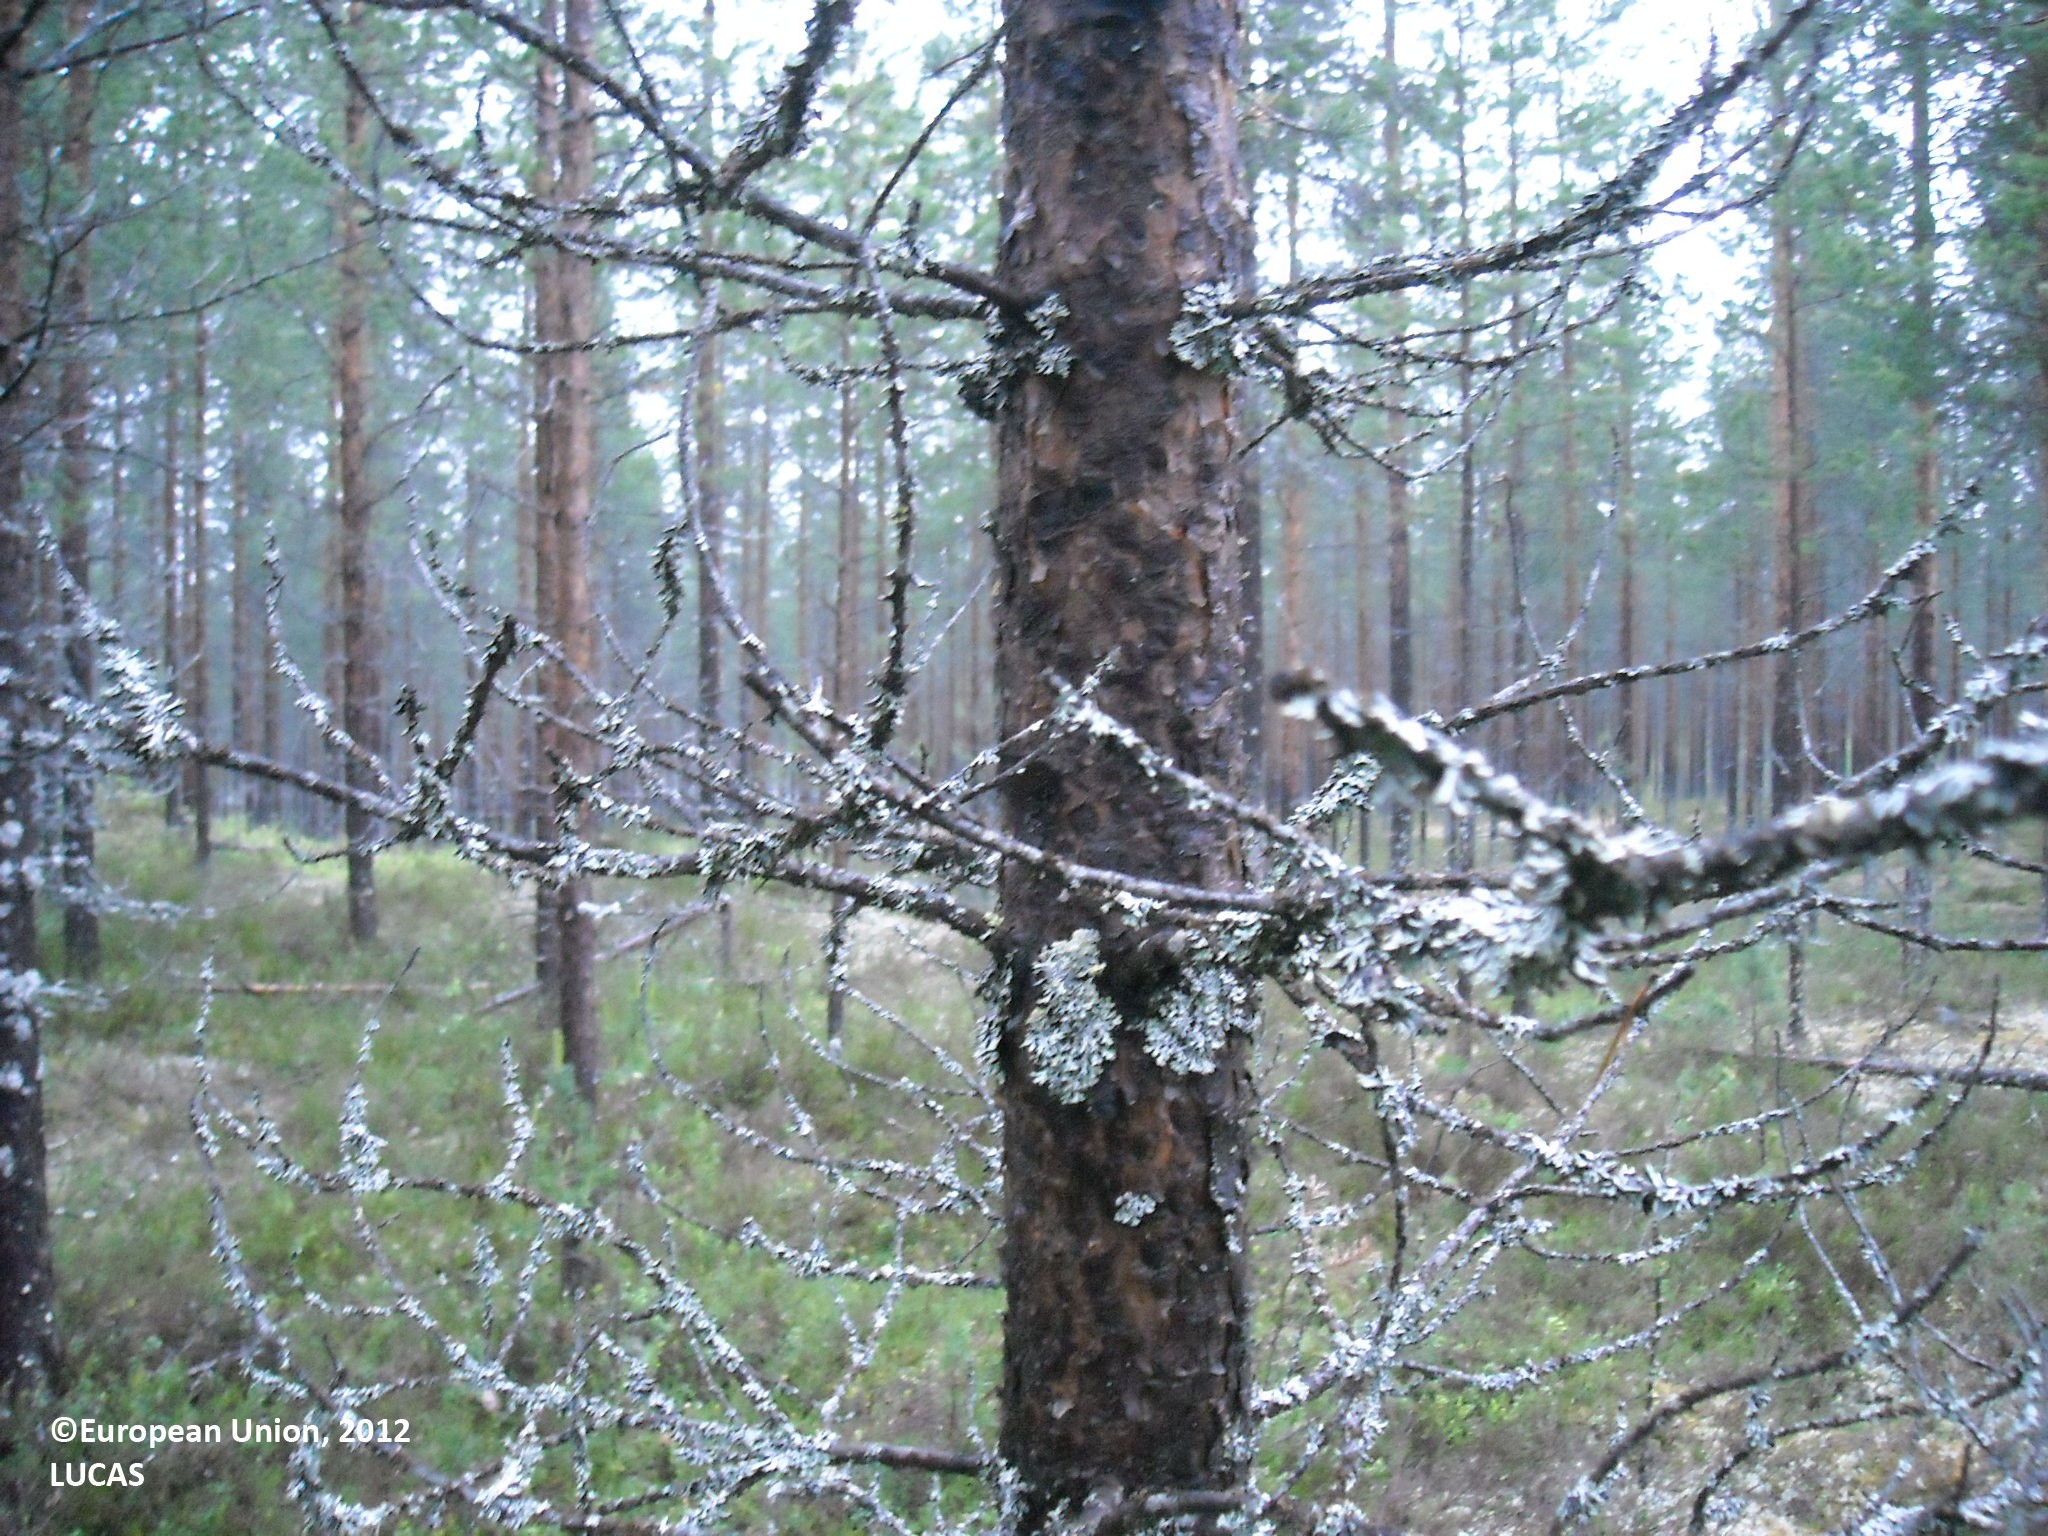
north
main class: Woodland
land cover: Pine dominated coniferous woodland
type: boreal forest
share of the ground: 25 - 50 %
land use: Forestry
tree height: > 5 m
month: July
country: FI
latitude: 64.9883
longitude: 28.0662
